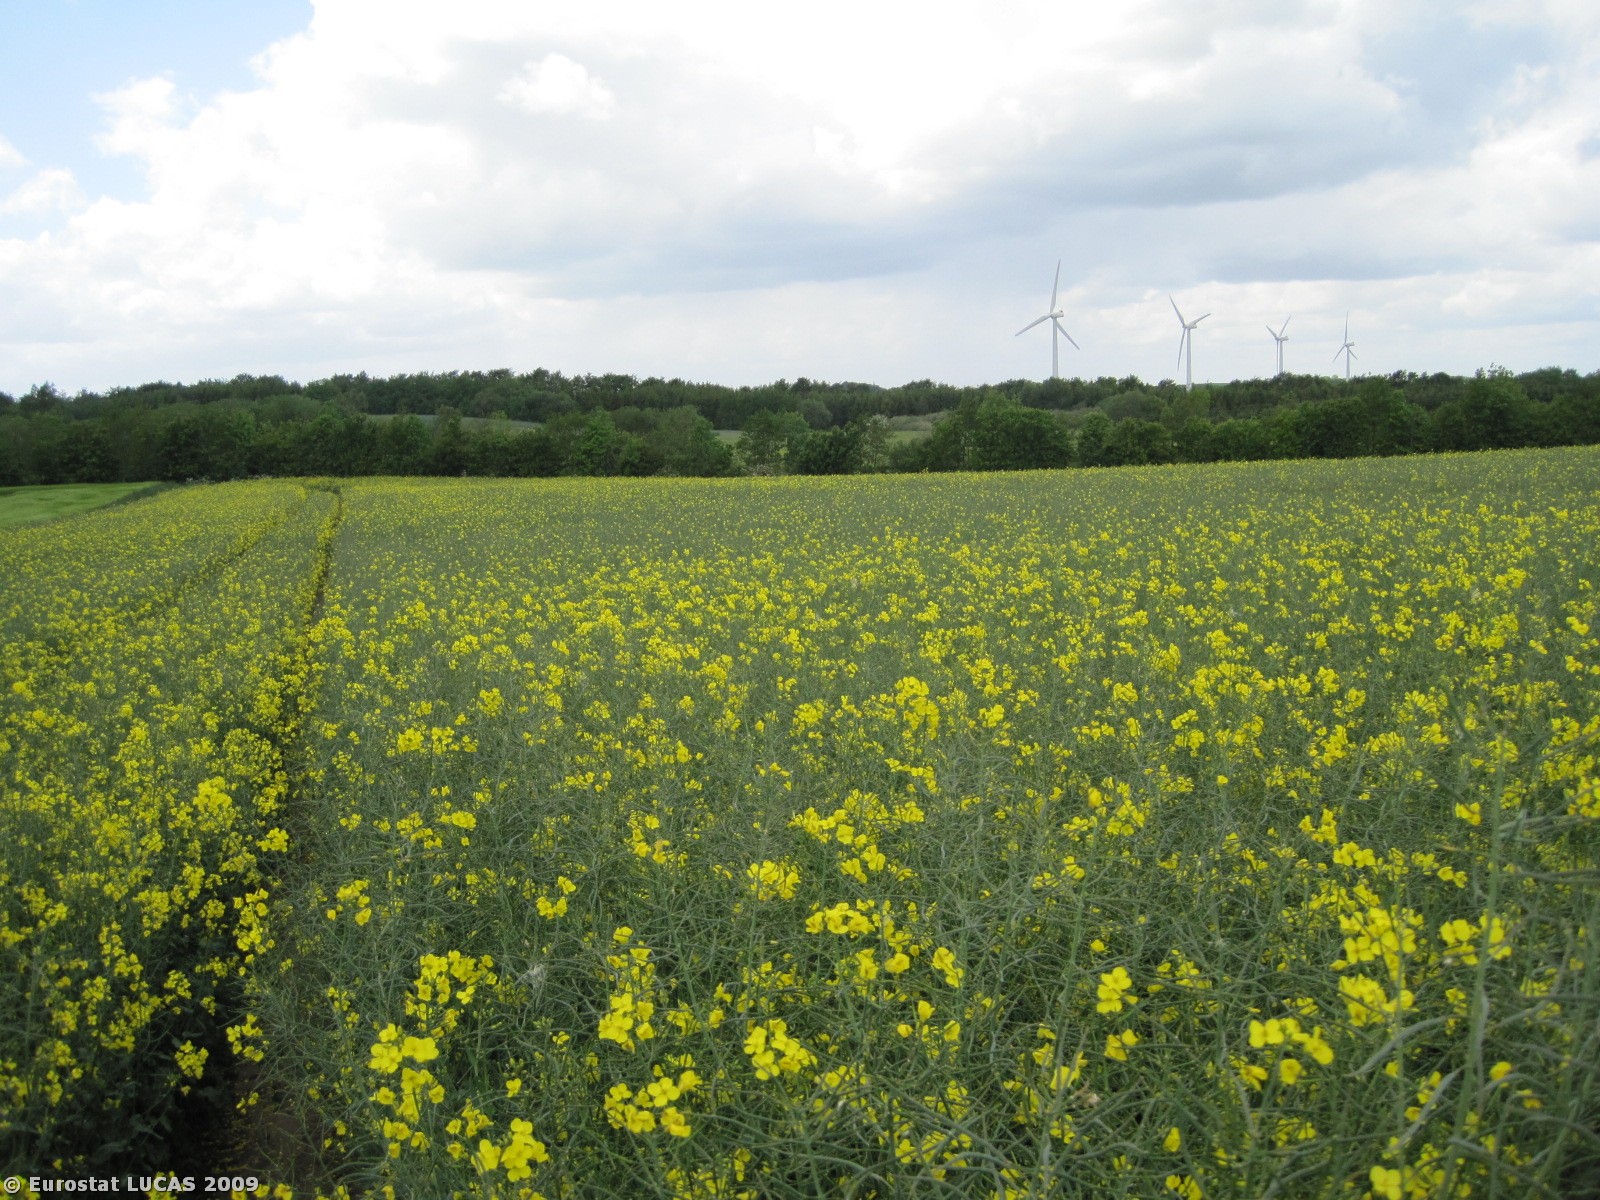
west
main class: Cropland
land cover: Rape and turnip rape
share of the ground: > 75 %
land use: Agriculture (excluding fallow land and kitchen gardens)
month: May
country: DK
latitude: 56.5652
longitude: 9.8862
